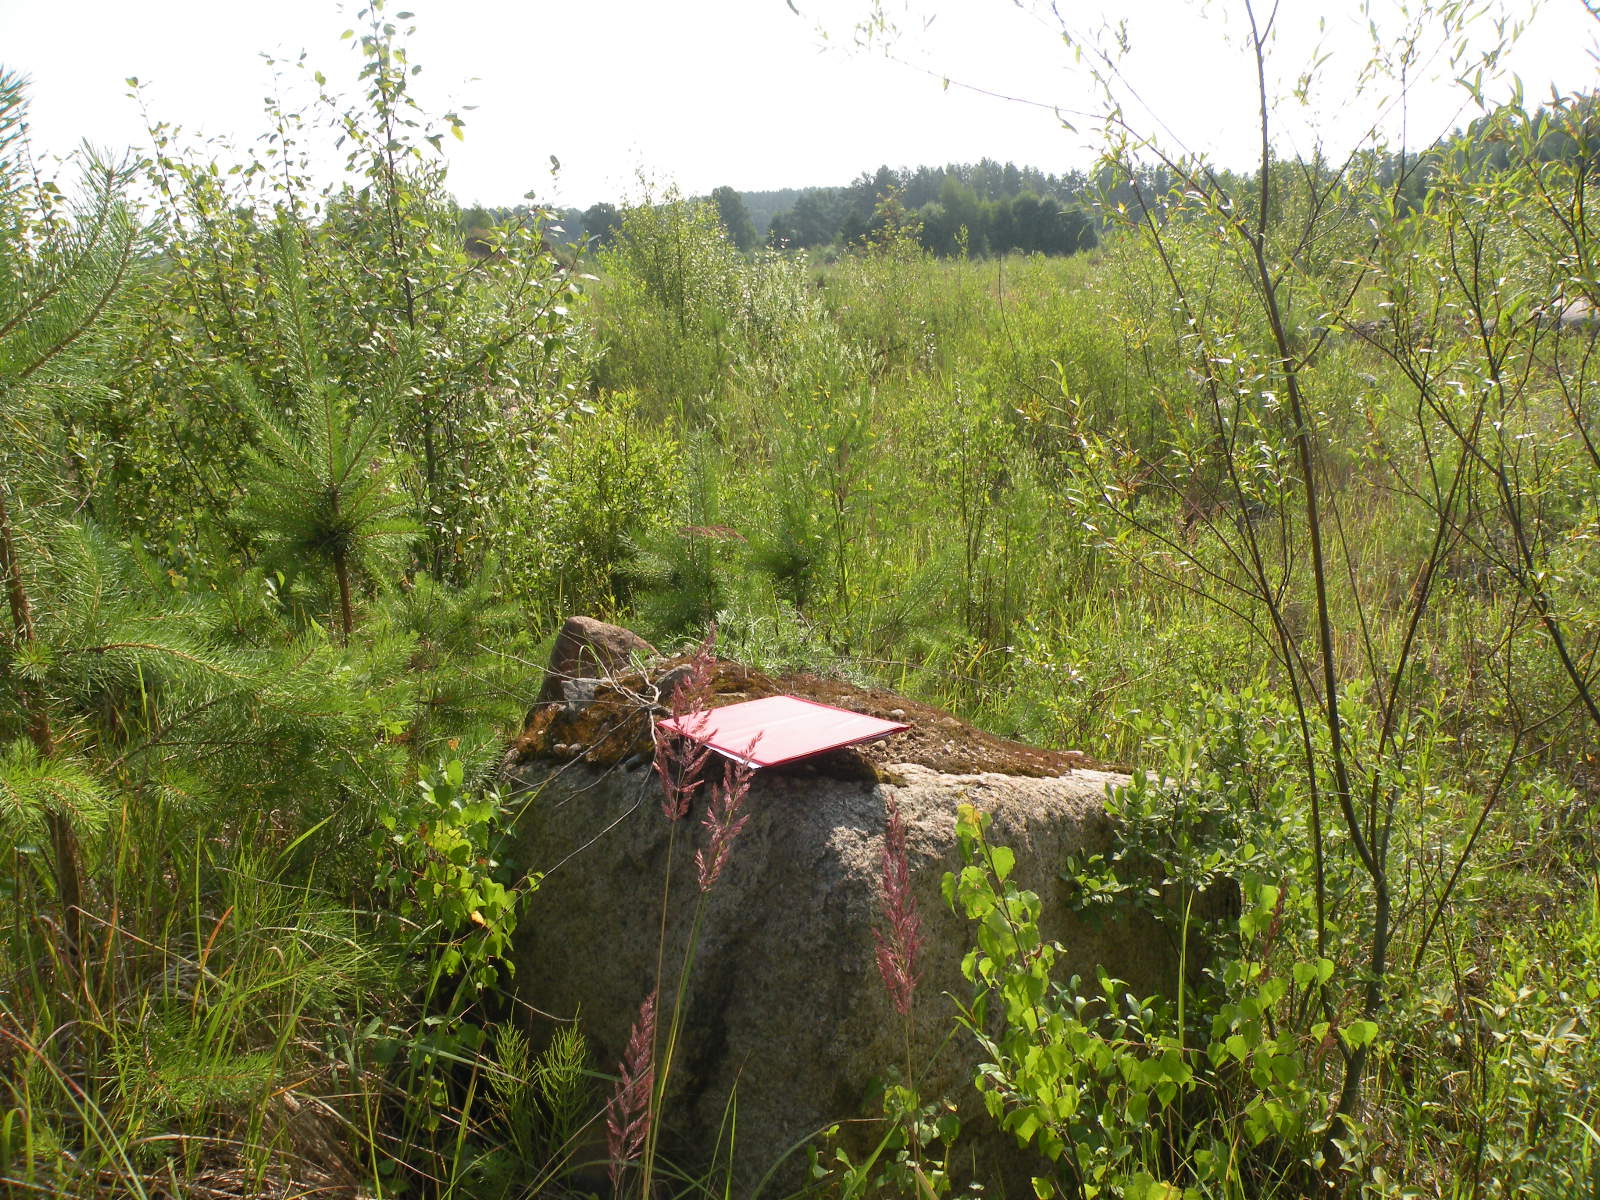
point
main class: Grassland
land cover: Grassland with sparse tree/shrub cover
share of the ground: > 75 %
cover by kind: herbaceous plants 90 %, broadleaved forest trees 5 %, shrubs 5 %
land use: Abandoned areas
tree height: < 5 m
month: July
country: LV
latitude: 55.9081
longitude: 26.7136
